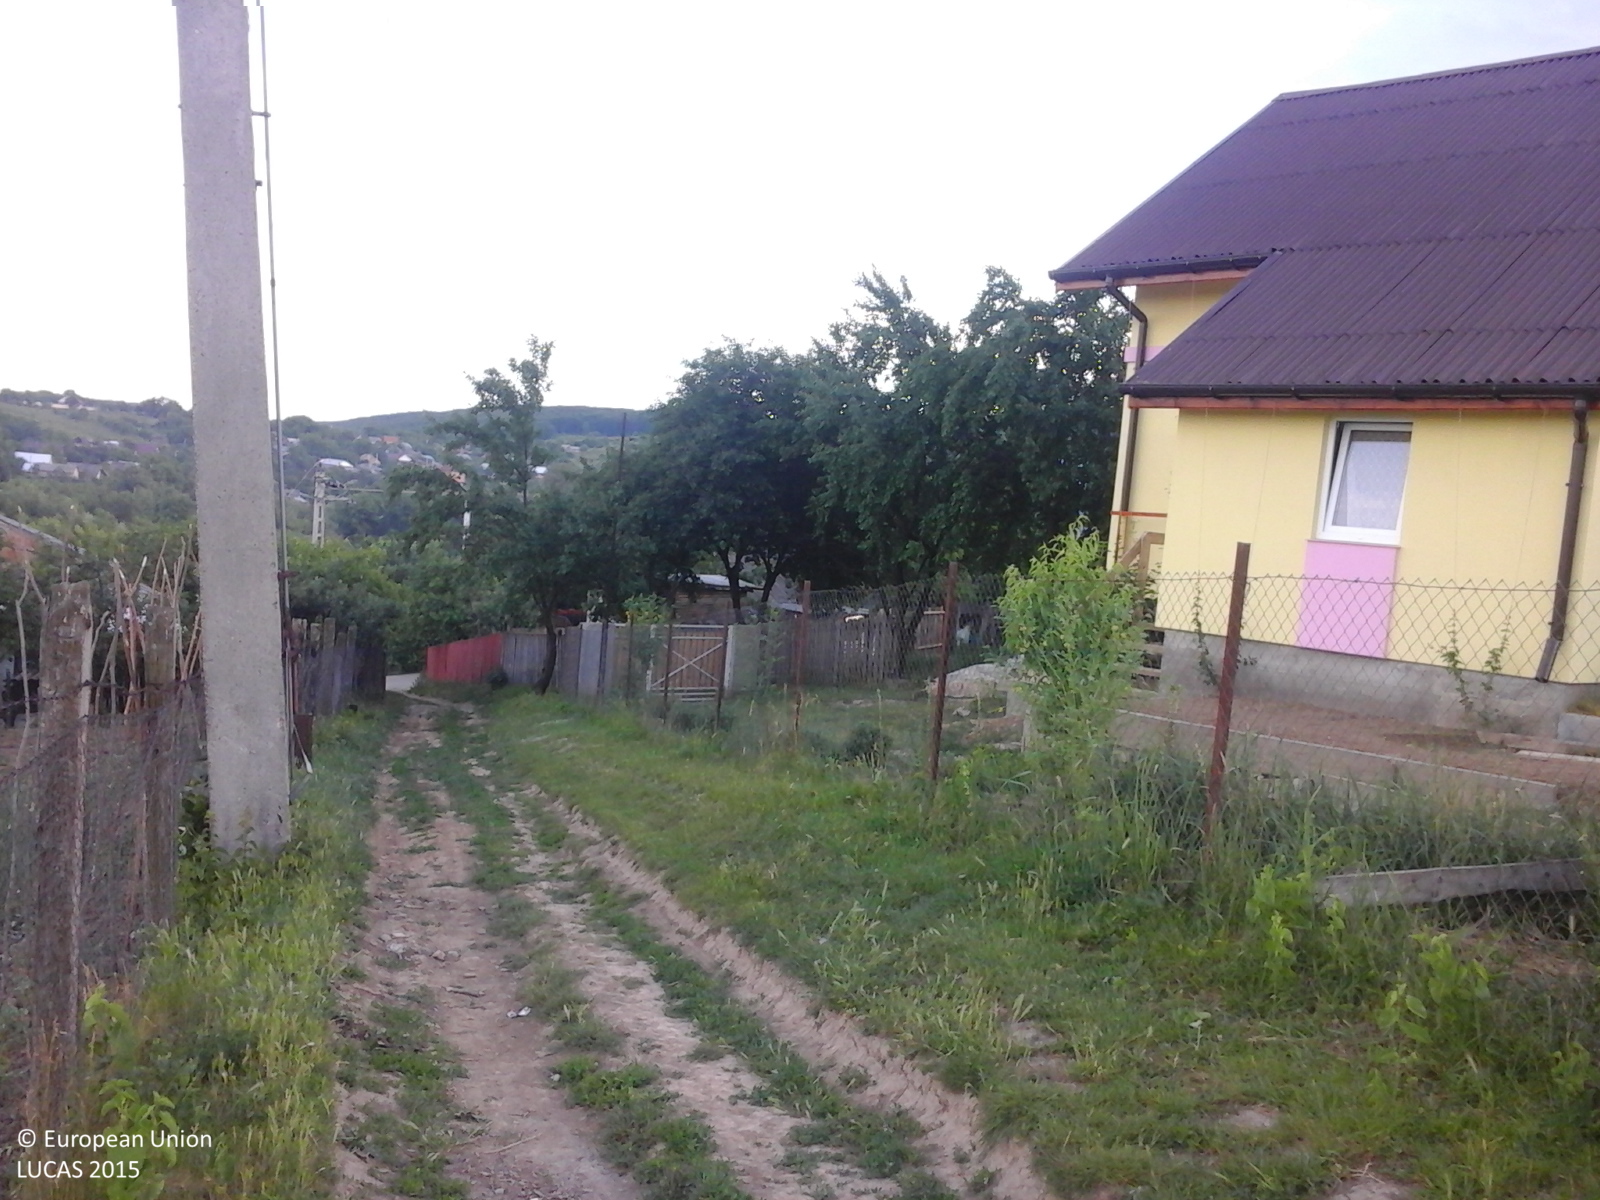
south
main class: Cropland
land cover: Other fresh vegetables
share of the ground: 25 - 50 %
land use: Kitchen garden
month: June
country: RO
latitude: 46.4077
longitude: 26.9124
